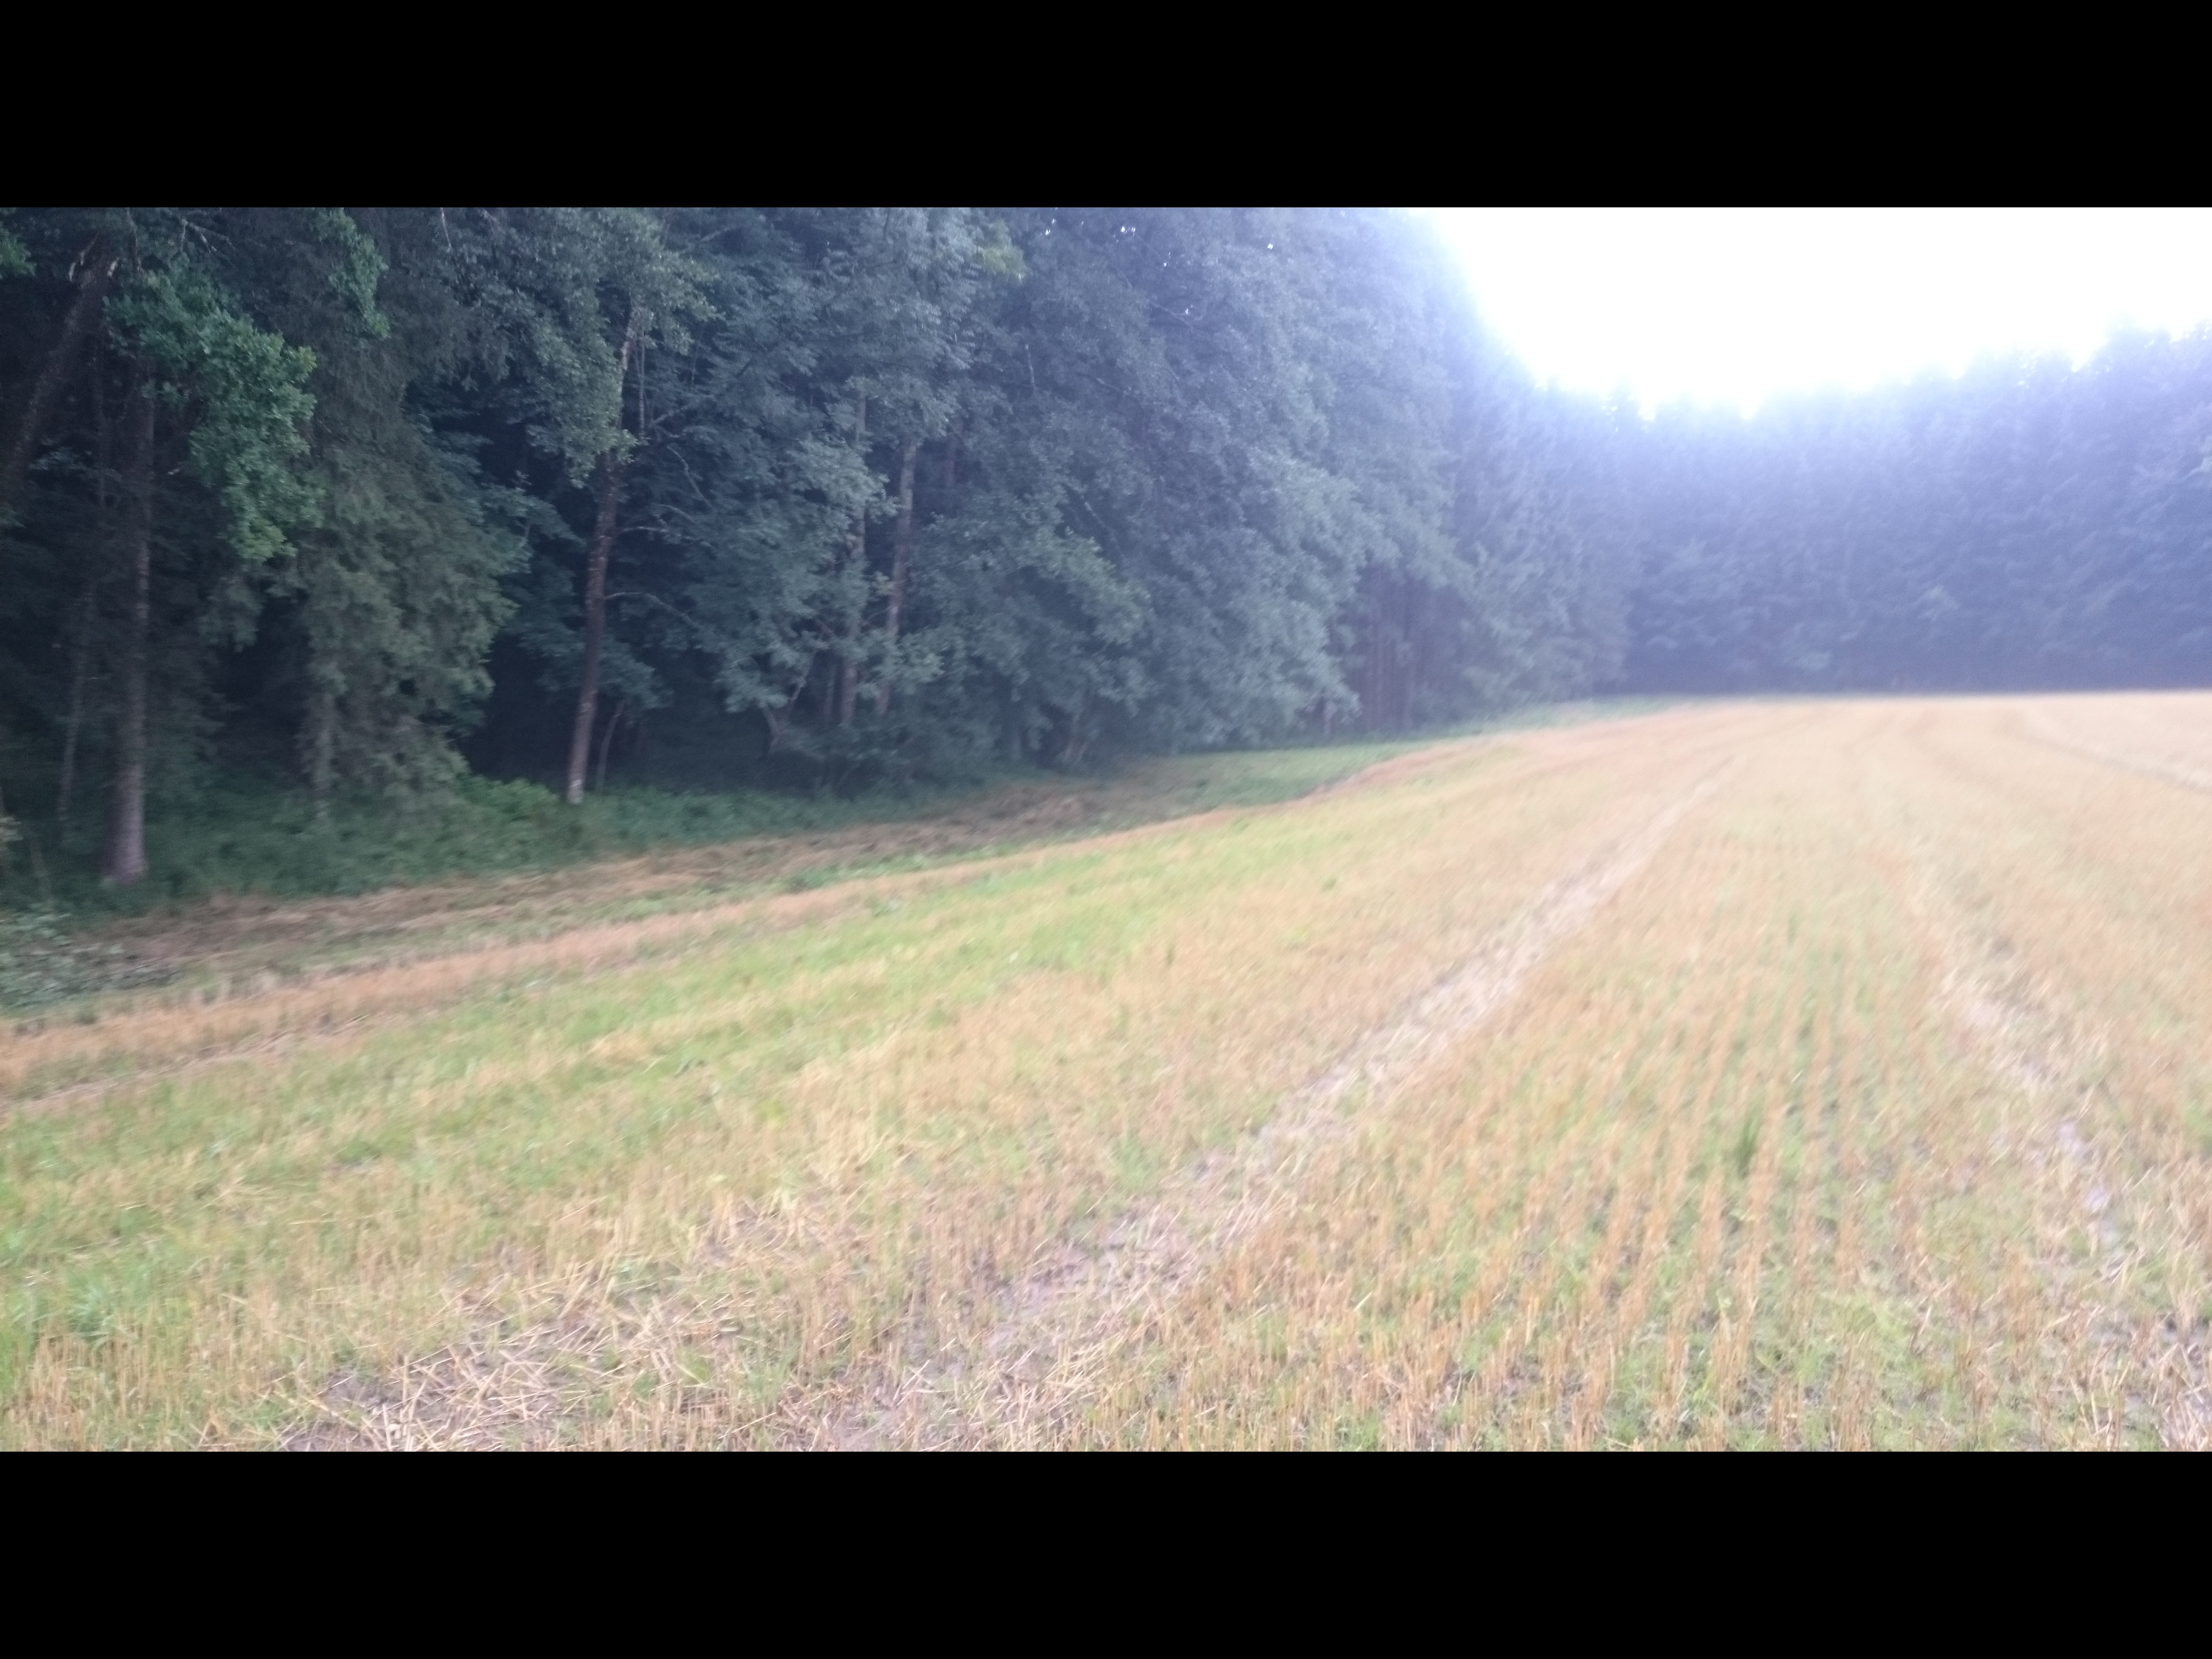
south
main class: Grassland
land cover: Spontaneously vegetated surfaces
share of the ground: > 75 %
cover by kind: herbaceous plants 100 %
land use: Agriculture (excluding fallow land and kitchen gardens)
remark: Harvested field
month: July
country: AT
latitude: 47.1926
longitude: 15.6892
